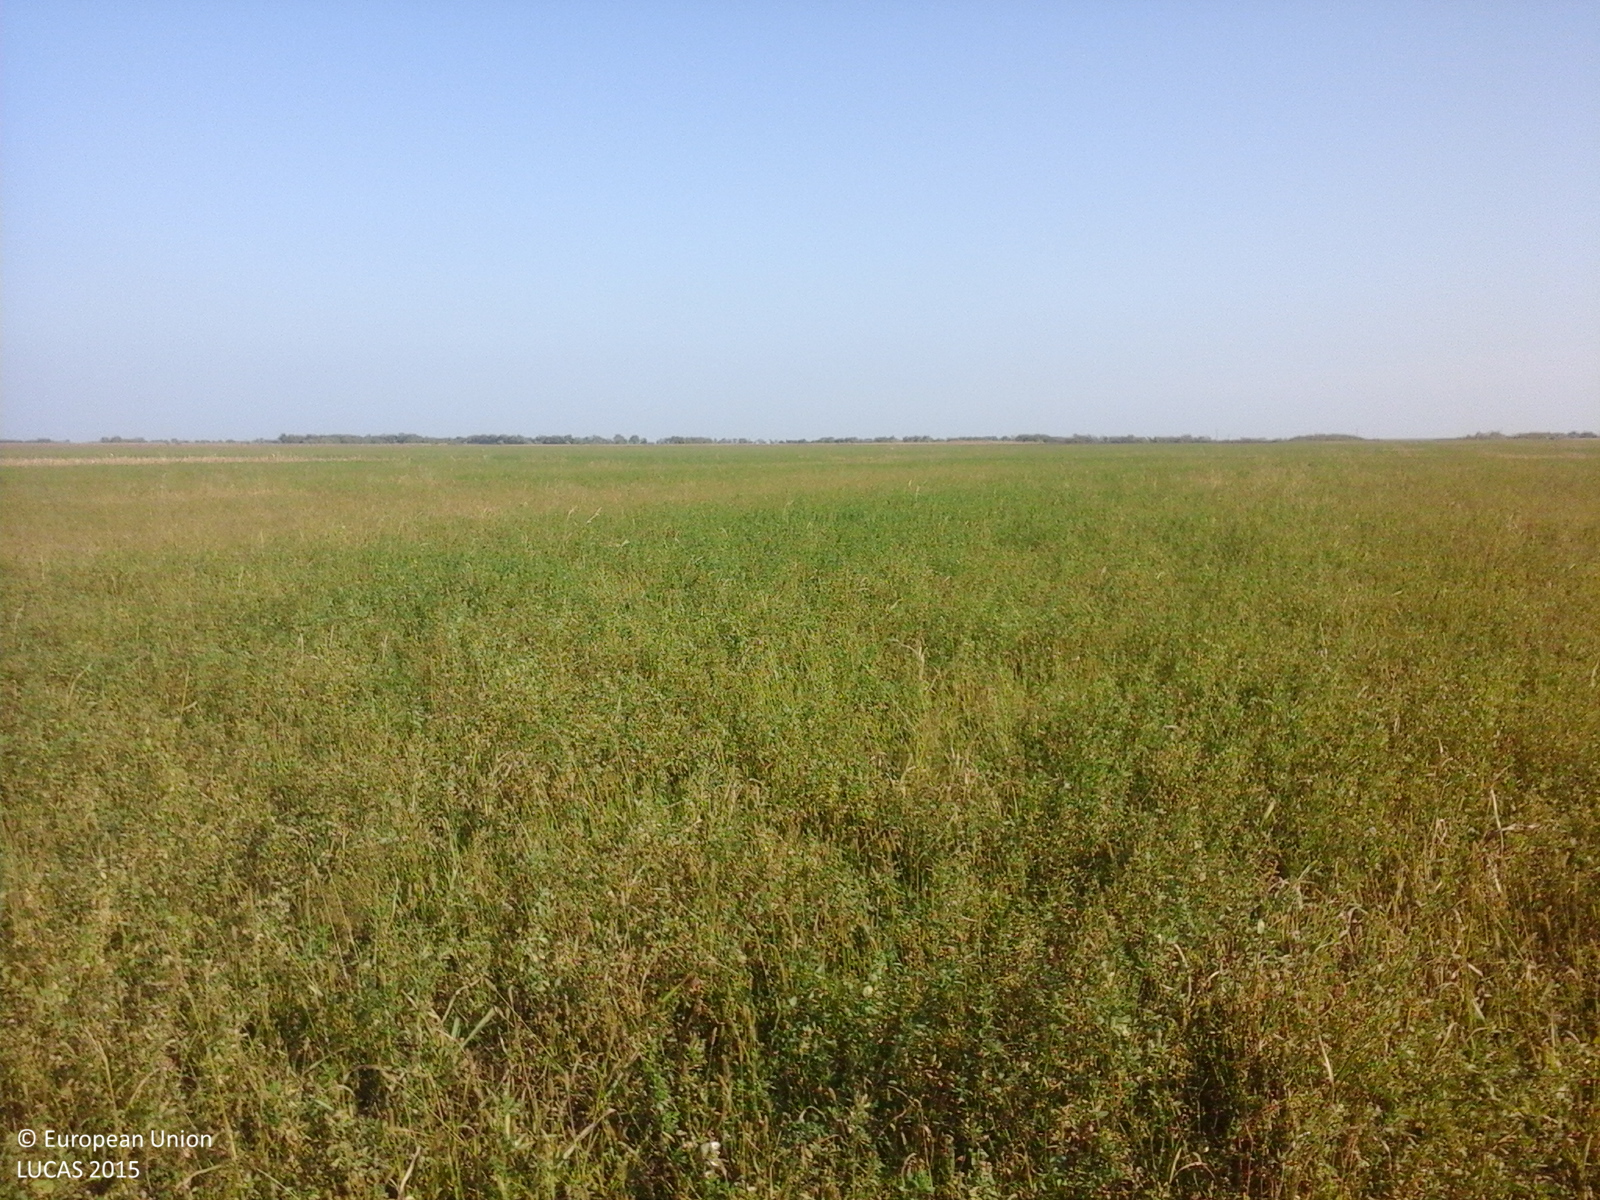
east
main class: Cropland
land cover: Lucerne
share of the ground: > 75 %
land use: Agriculture (excluding fallow land and kitchen gardens)
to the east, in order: Lucerne; Grass margins; Tracks; Grass margins; Lucerne
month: October
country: RO
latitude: 45.2086
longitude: 26.8232
